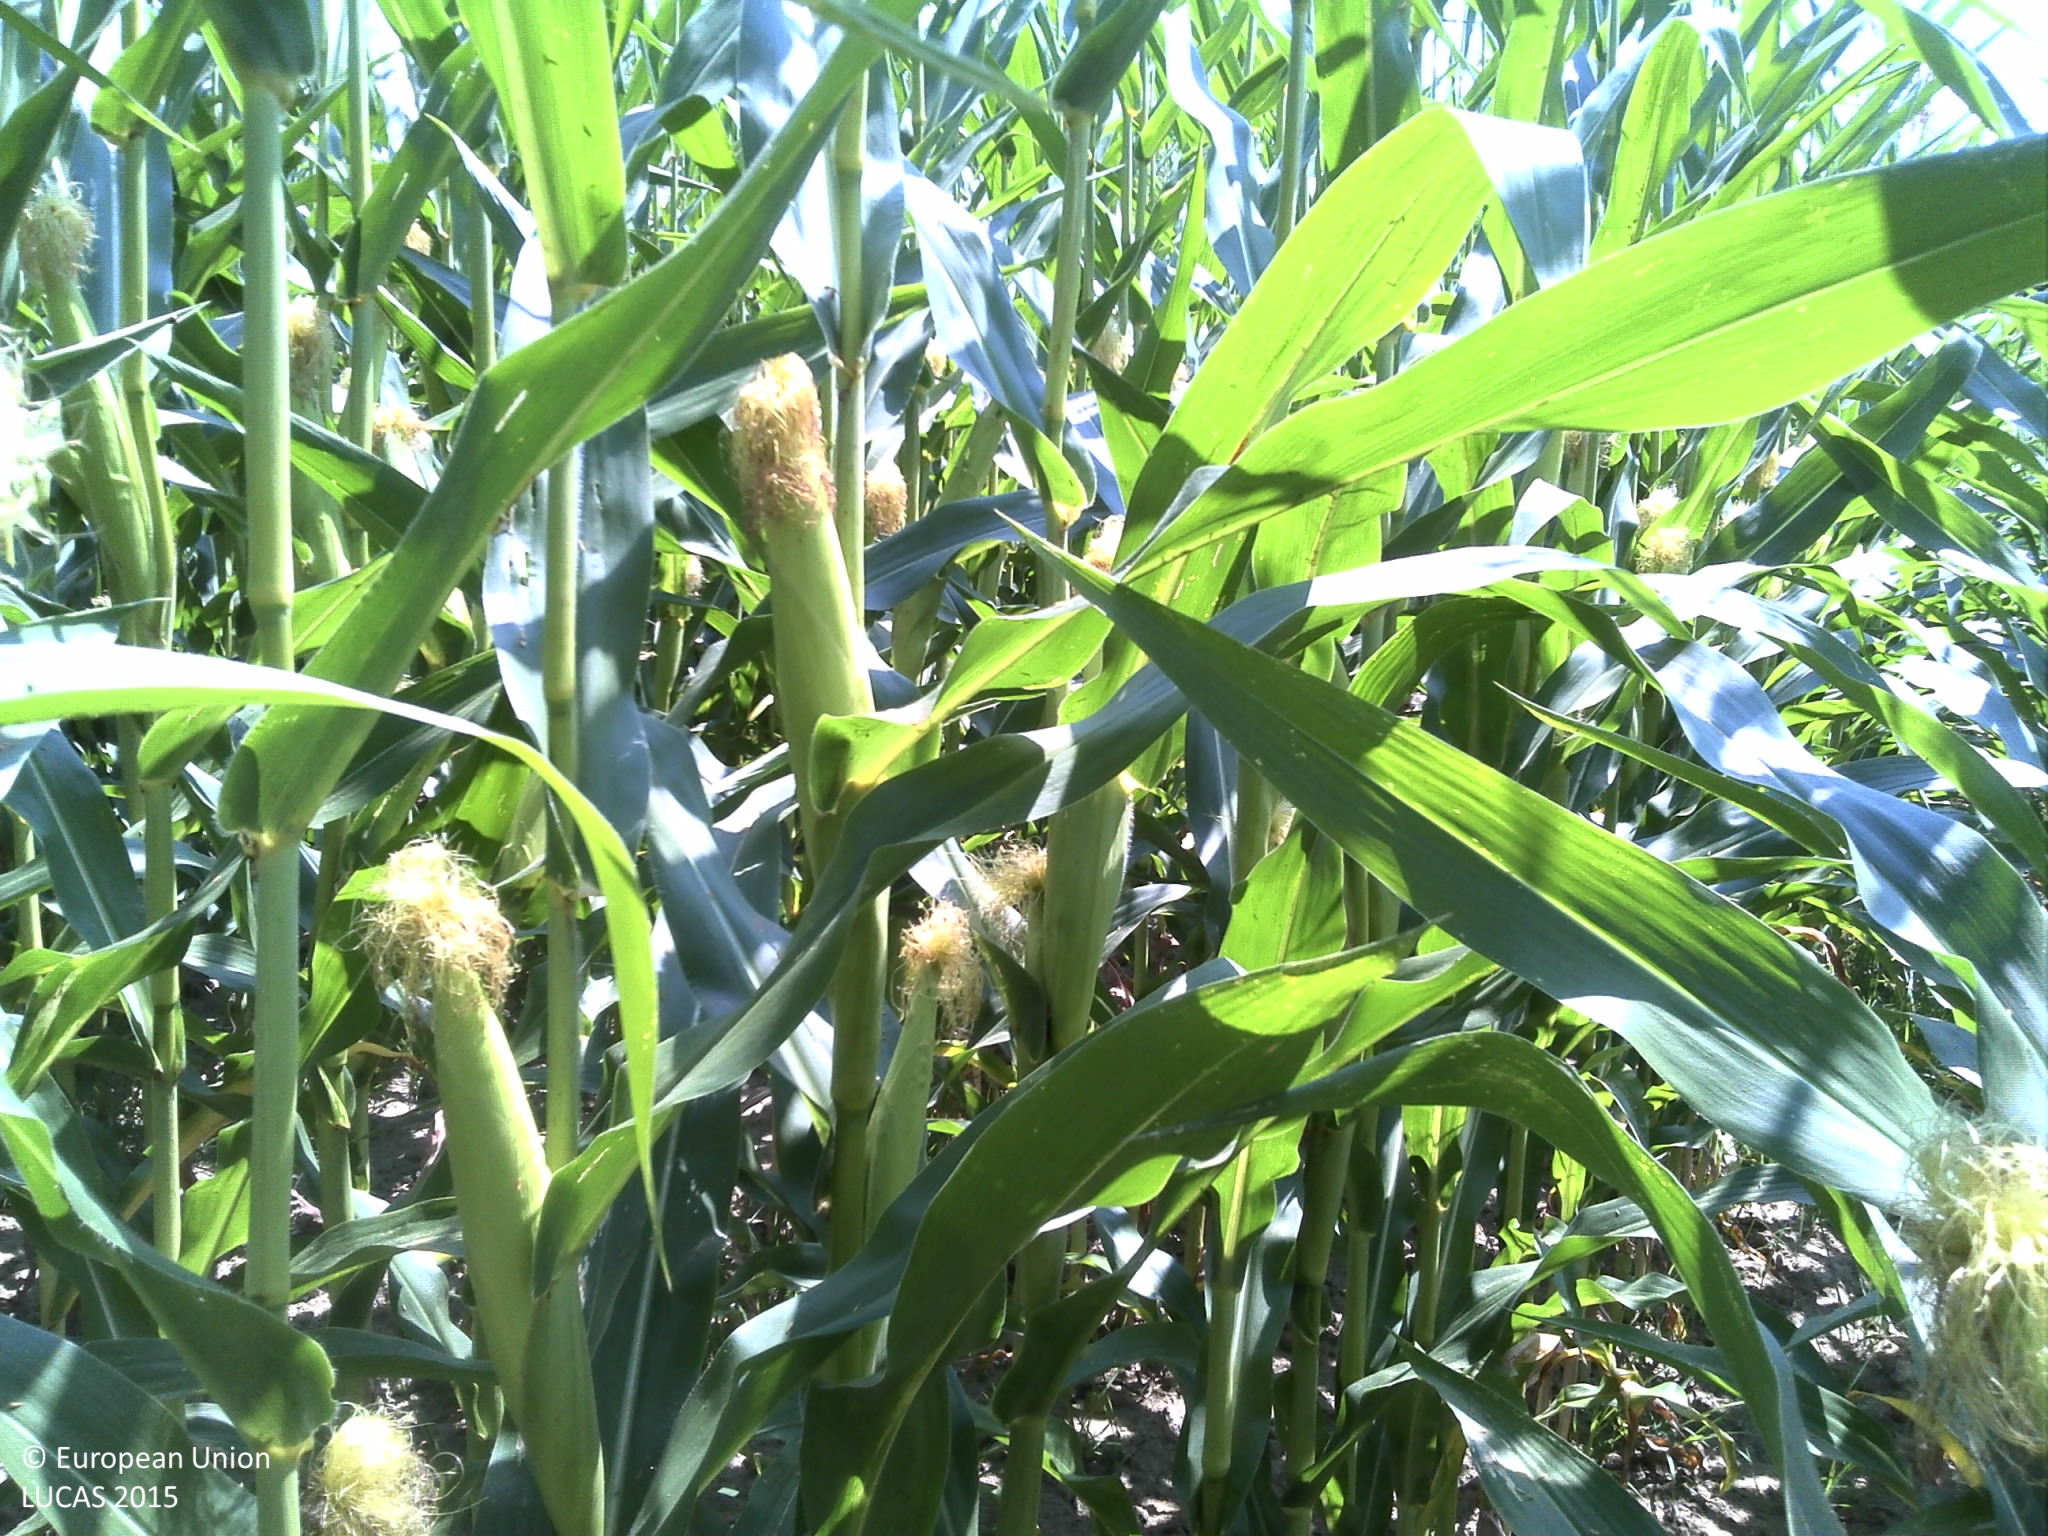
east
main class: Cropland
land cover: Maize
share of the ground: > 75 %
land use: Agriculture (excluding fallow land and kitchen gardens)
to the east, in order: Maize; Grass margins; Lines of trees; Ditches and canals; Tracks; Shrubland with sparse tree cover; Maize; Shrubland with sparse tree cover; Maize
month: July
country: HR
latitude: 45.8660
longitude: 16.7628
